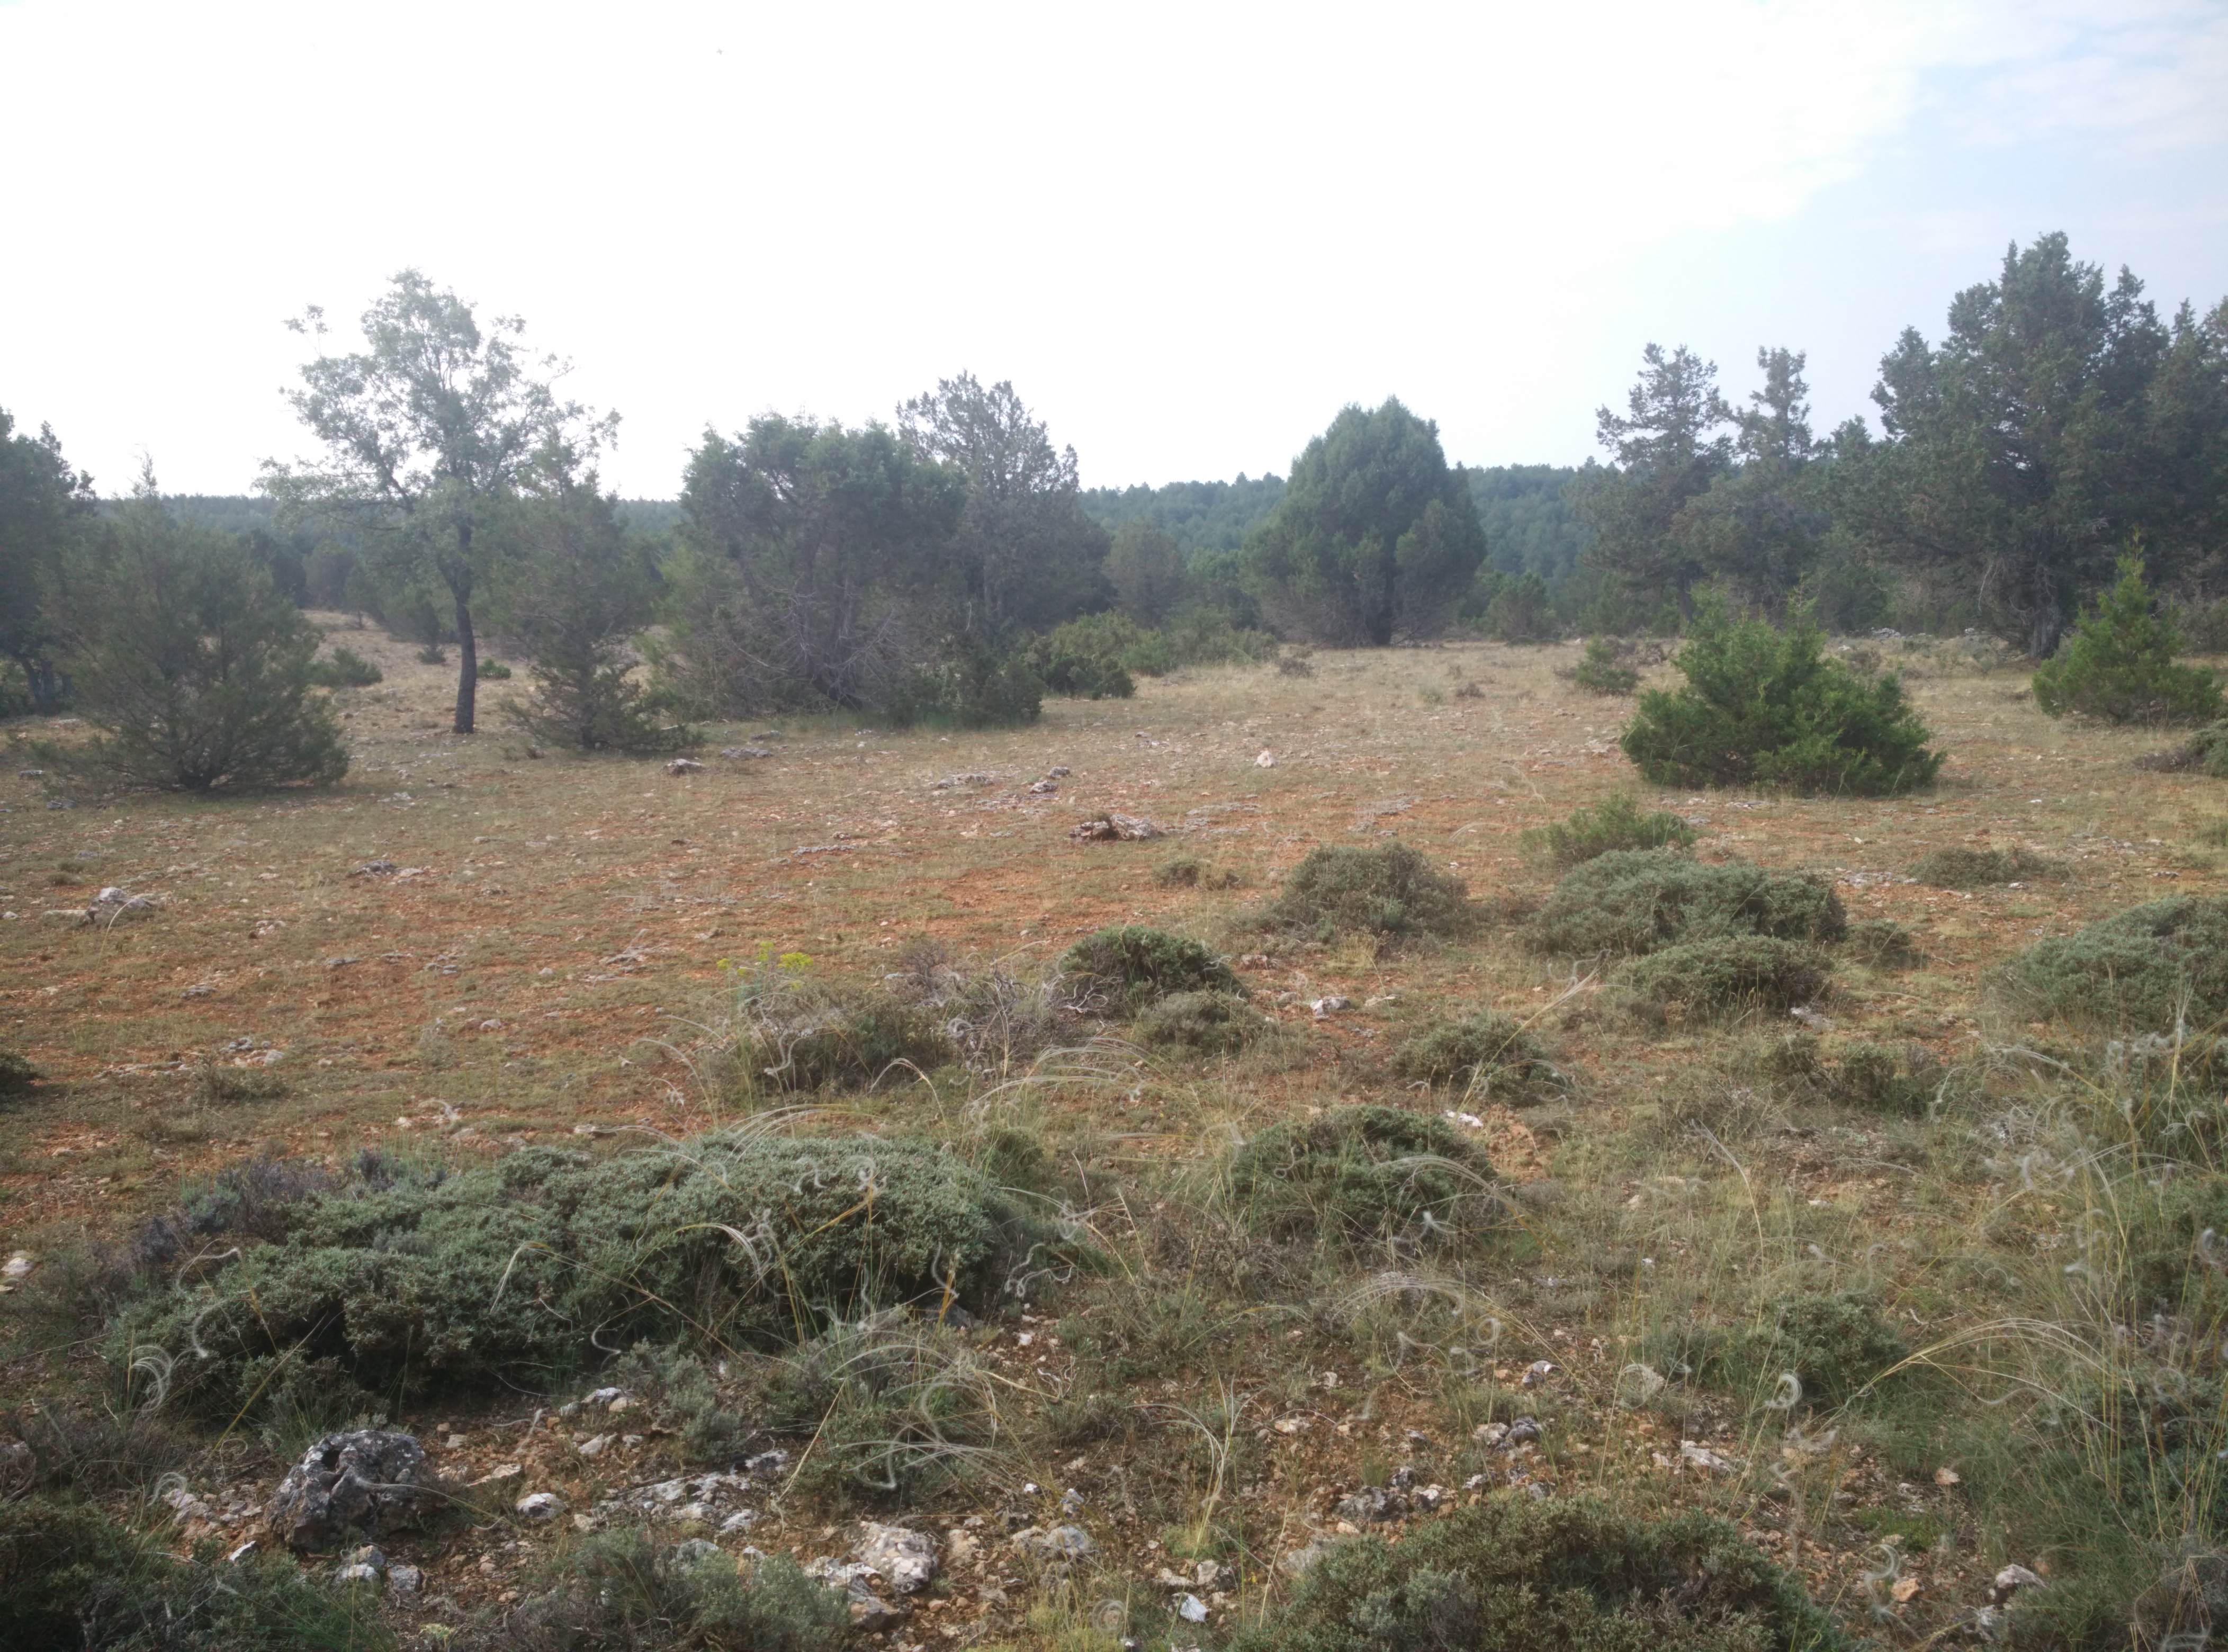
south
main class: Woodland
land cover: Other coniferous woodland
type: coniferous forest of the mediterranean region
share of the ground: 25 - 50 %
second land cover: Shrubland without tree cover
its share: 10 - 25 %
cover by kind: unconsolidated bare surface 60 %, coniferous forest trees 25 %, shrubs 10 %, herbaceous plants 5 %
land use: Forestry
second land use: Agriculture (excluding fallow land and kitchen gardens)
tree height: > 5 m
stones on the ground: > 50 %
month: June
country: ES
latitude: 40.7136
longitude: -2.0132
